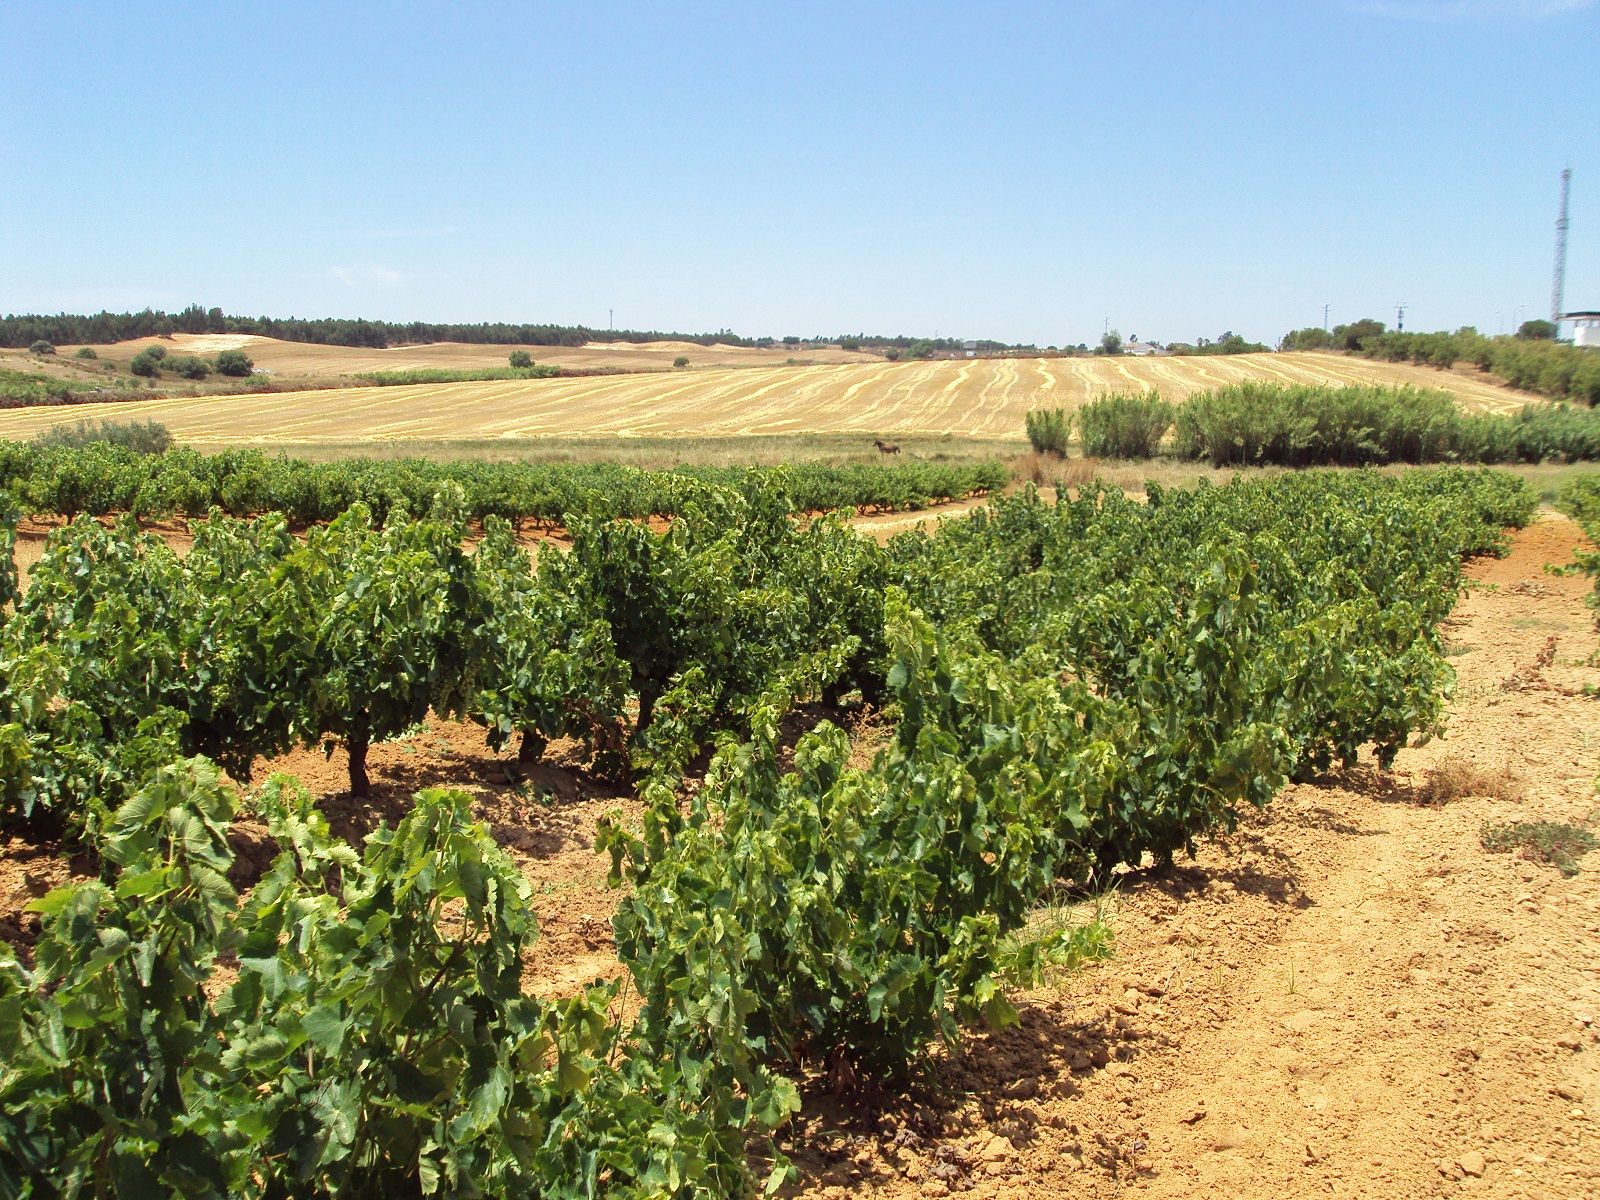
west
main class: Cropland
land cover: Vineyards
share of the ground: > 75 %
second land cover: Other bare soil
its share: > 75 %
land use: Agriculture (excluding fallow land and kitchen gardens)
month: June
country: ES
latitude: 37.3493
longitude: -6.5942
